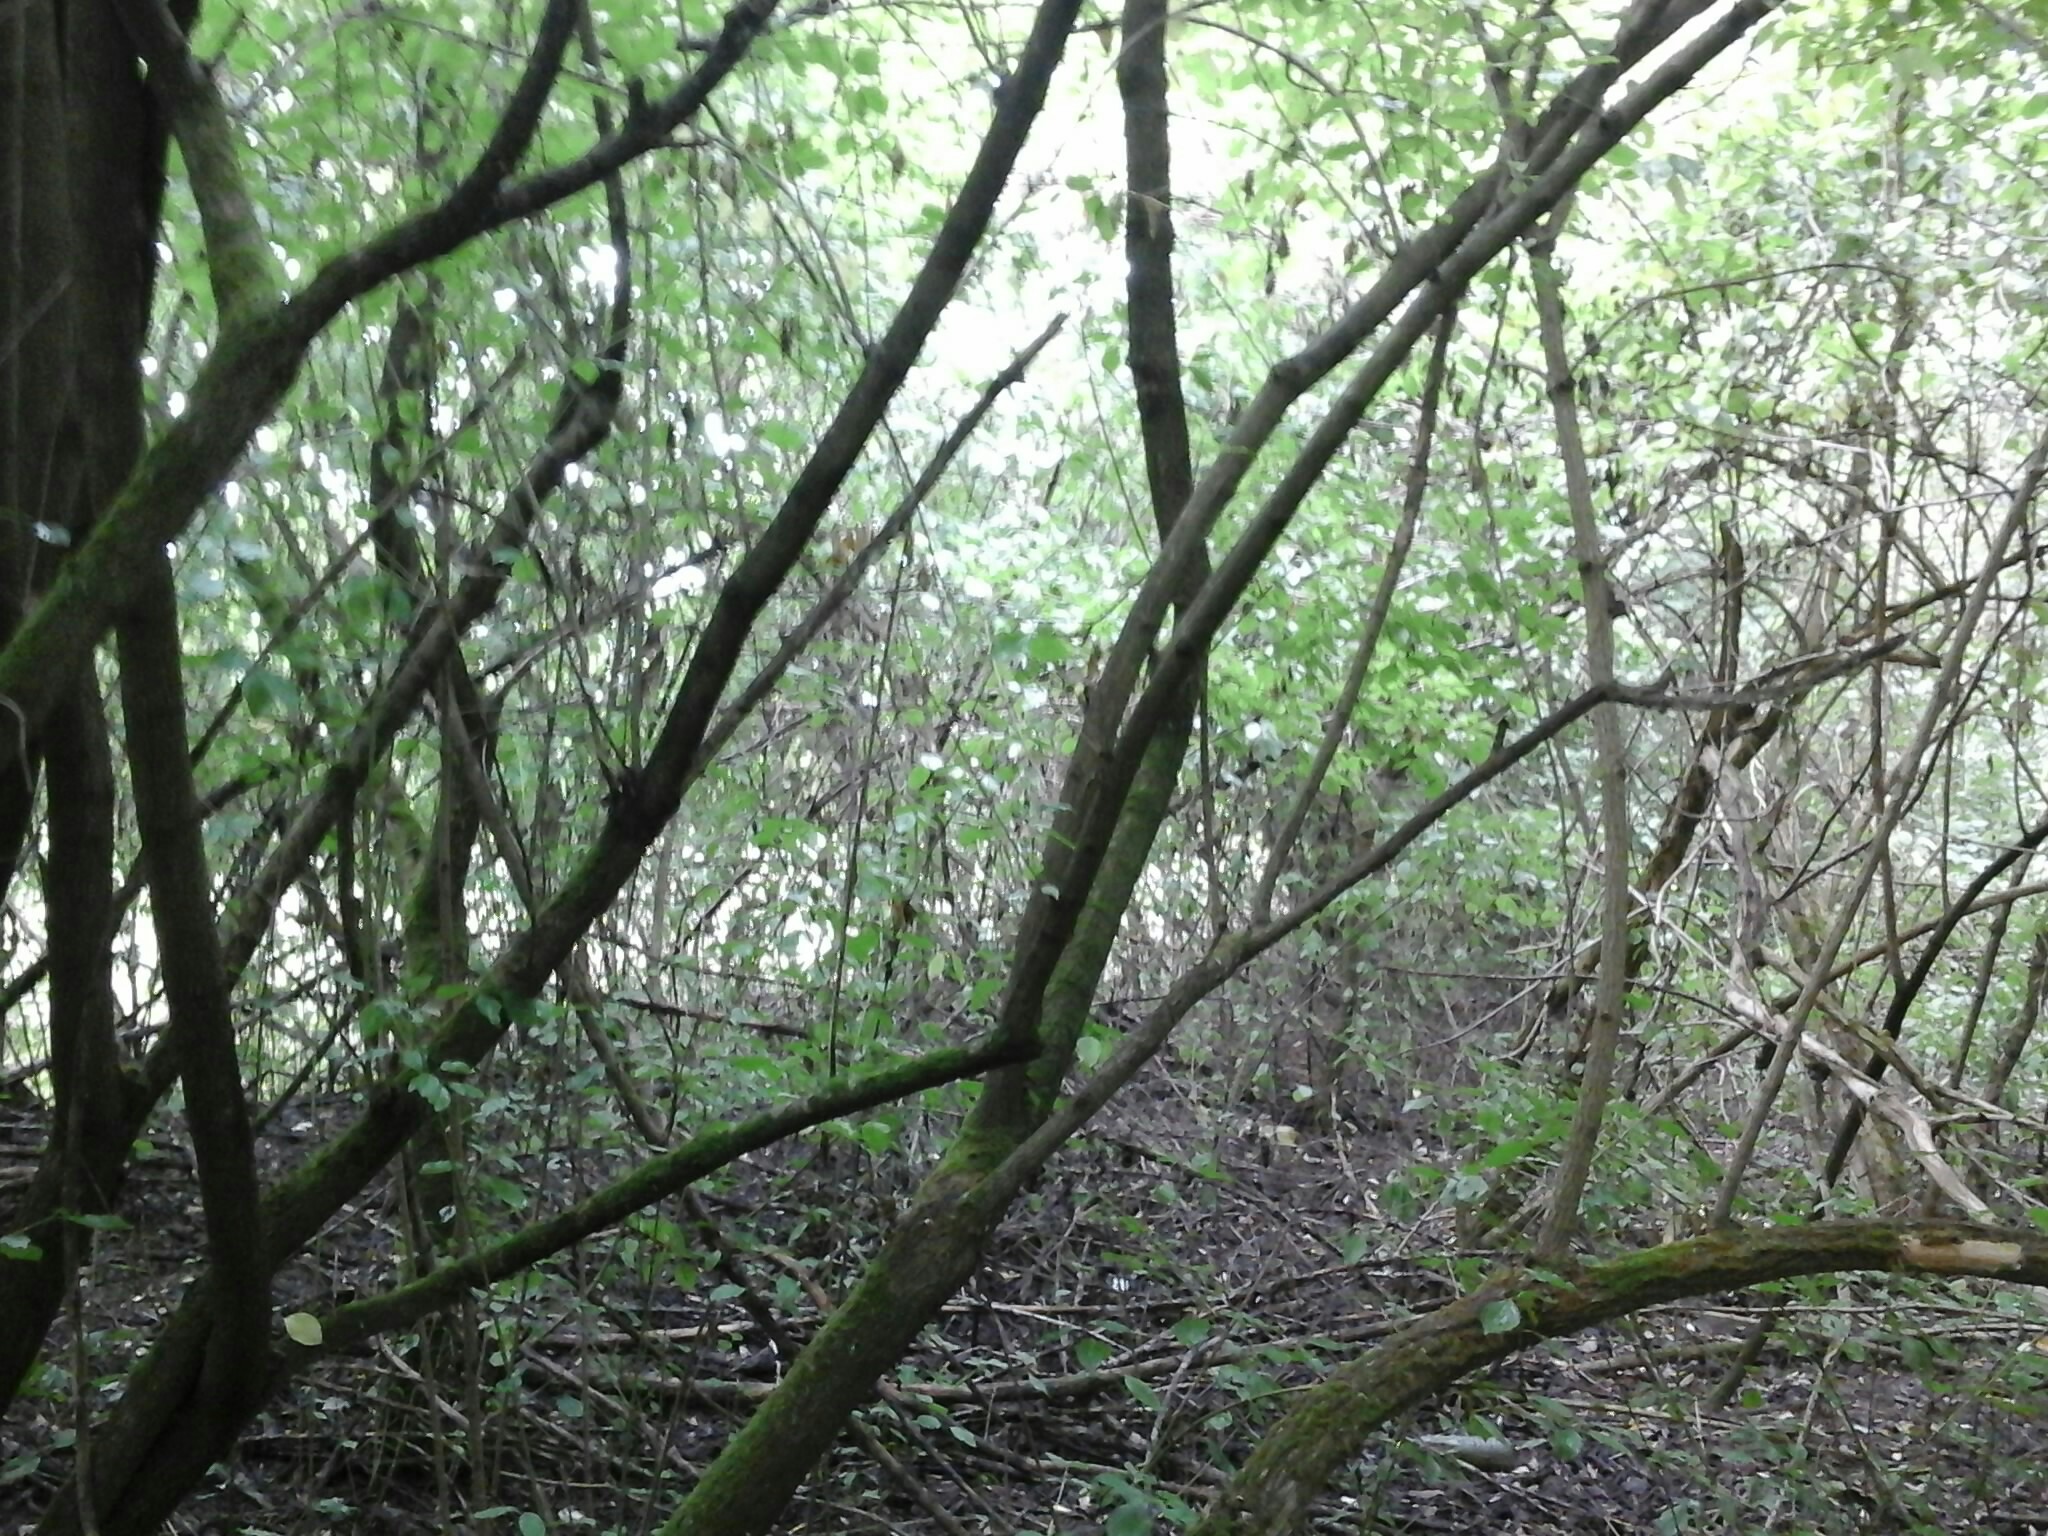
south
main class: Woodland
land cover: Broadleaved woodland
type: floodplain forest
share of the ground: > 75 %
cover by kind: broadleaved forest trees 95 %, herbaceous plants 5 %
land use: Forestry
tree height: > 5 m
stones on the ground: < 10 %
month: July
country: HU
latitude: 48.3362
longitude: 22.2662
